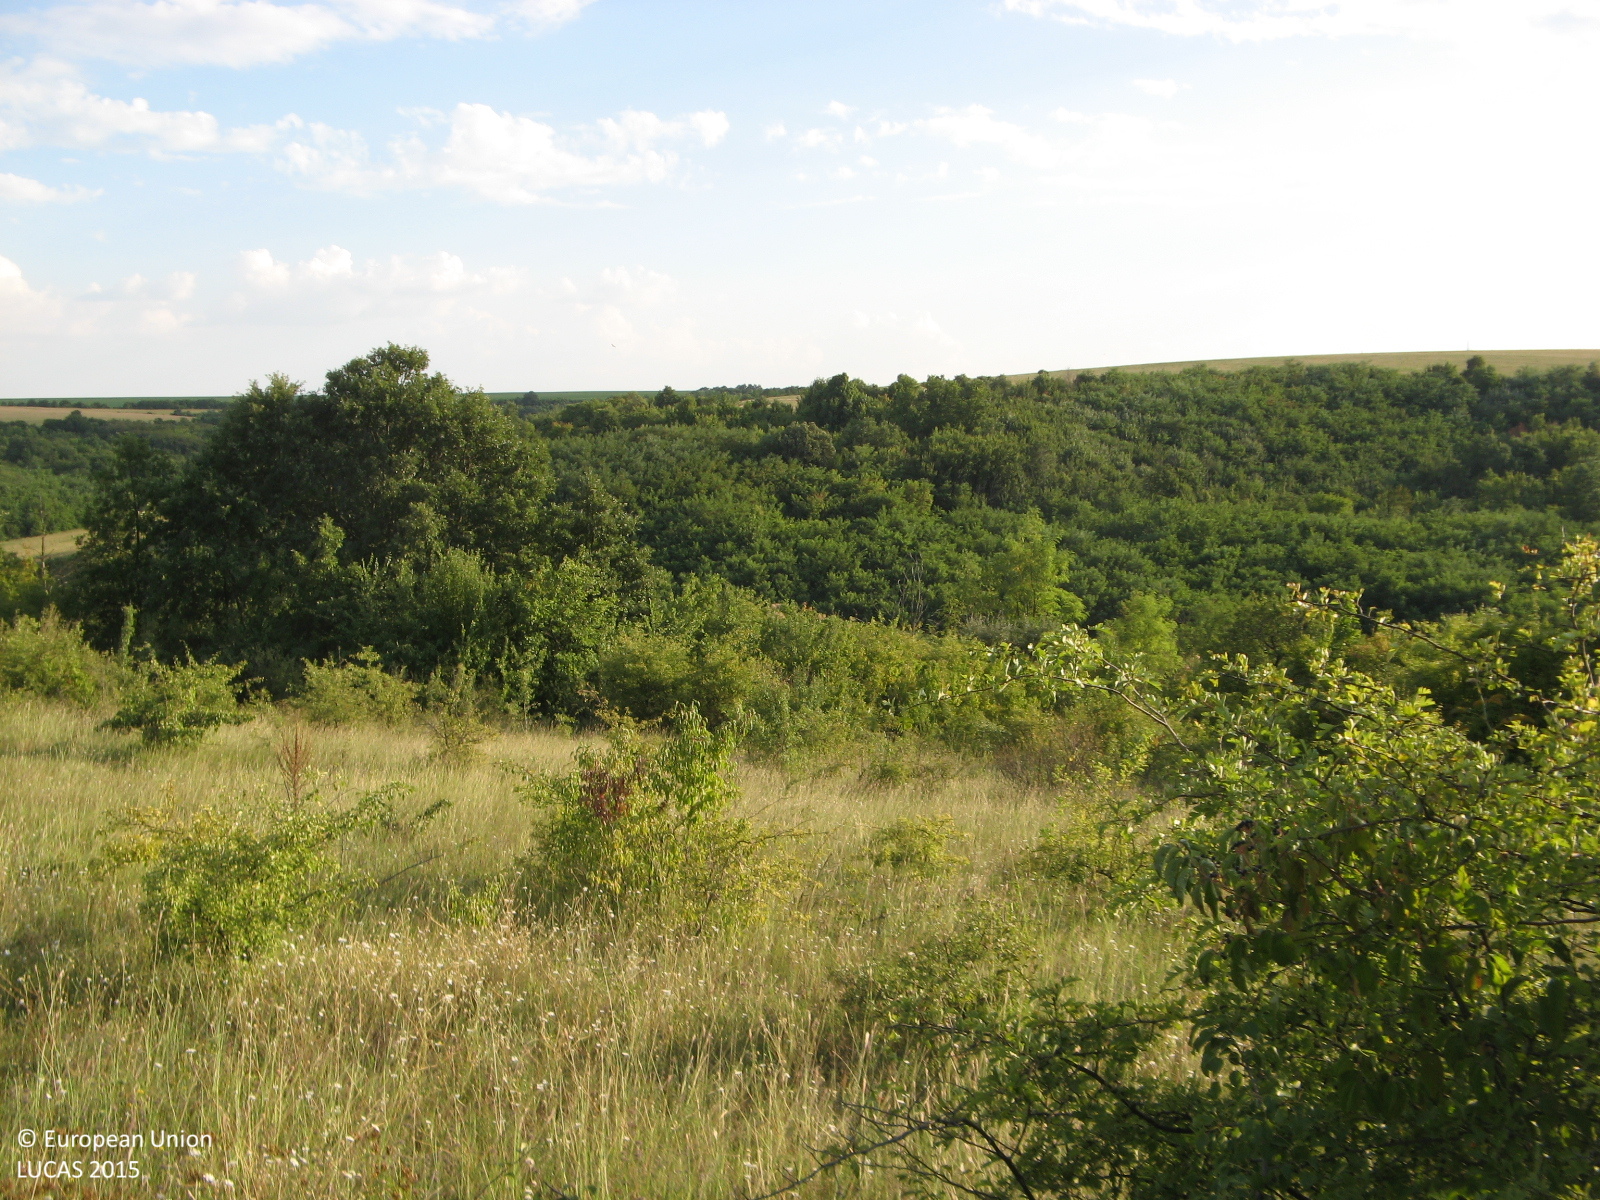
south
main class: Grassland
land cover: Grassland with sparse tree/shrub cover
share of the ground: > 75 %
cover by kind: herbaceous plants 85 %, shrubs 10 %, broadleaved forest trees 5 %
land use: Abandoned areas
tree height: < 5 m
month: August
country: BG
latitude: 43.5321
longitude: 25.8163
